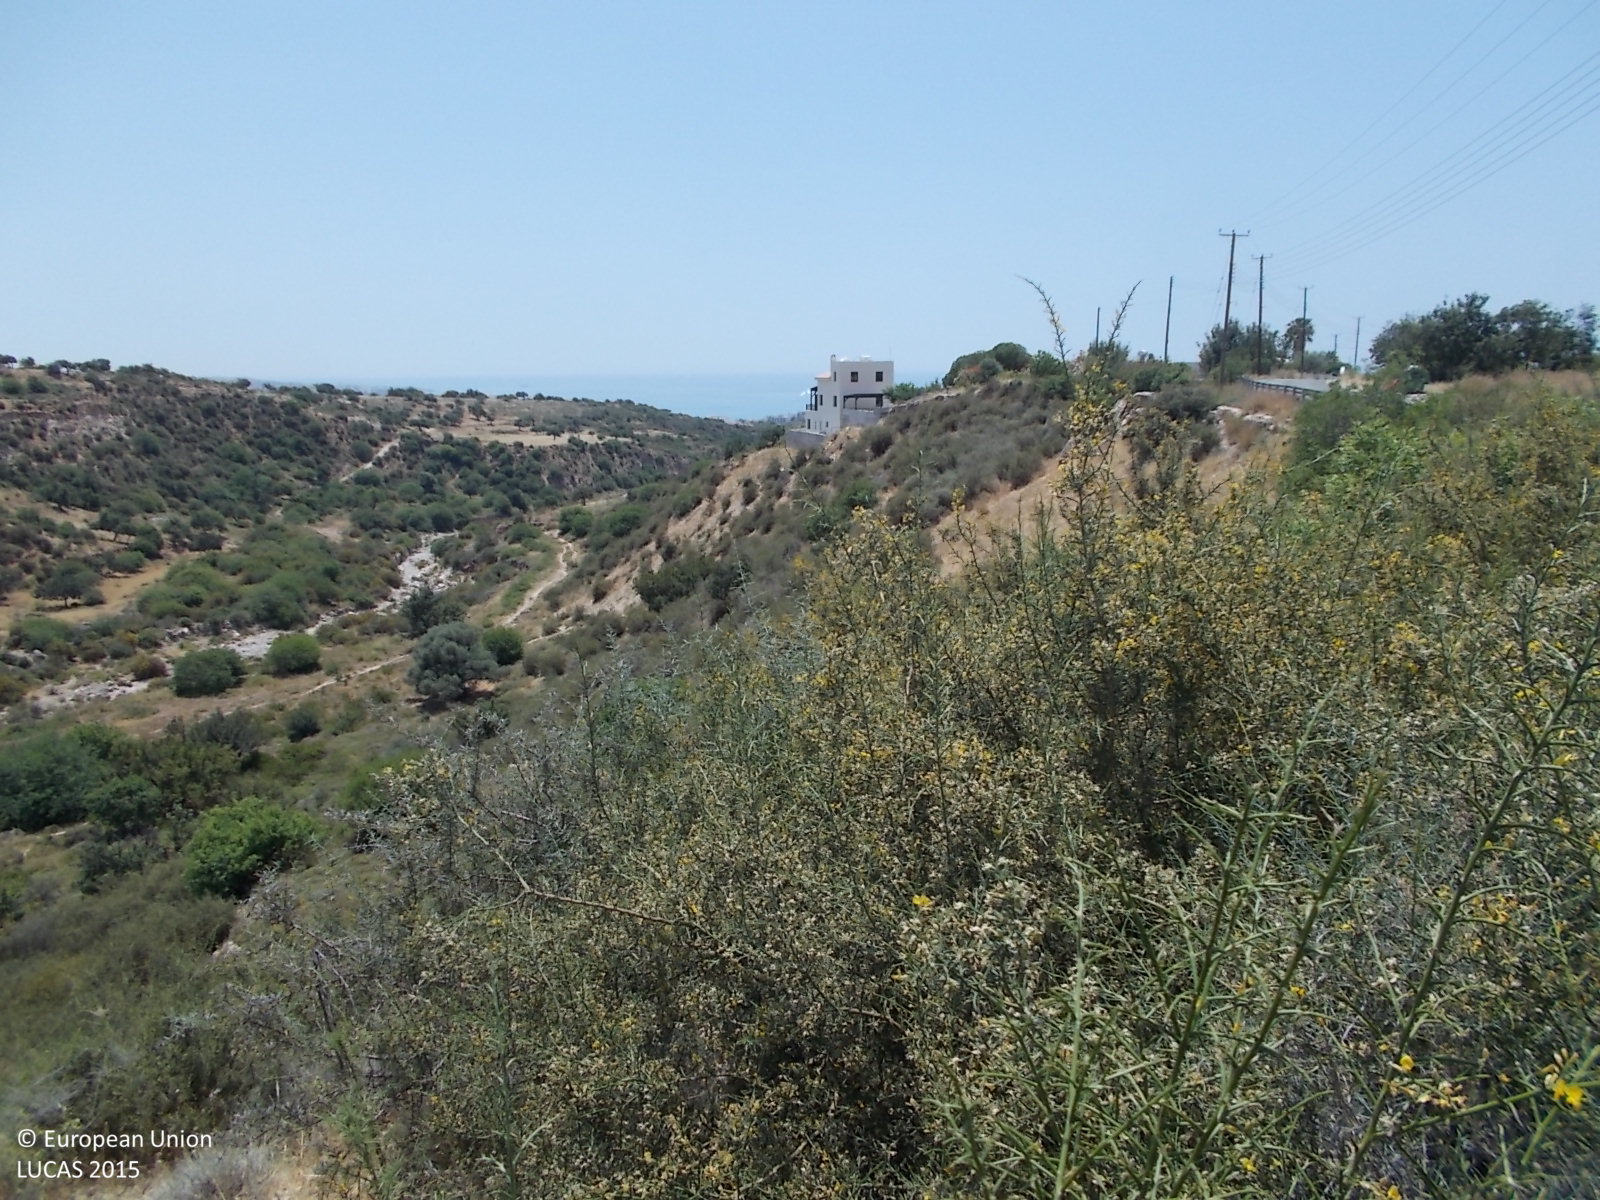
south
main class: Shrubland
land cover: Shrubland without tree cover
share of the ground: > 75 %
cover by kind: shrubs 75 %, herbaceous plants 15 %, unconsolidated bare surface 10 %
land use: Semi-natural and natural areas not in use
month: May
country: CY
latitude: 34.8734
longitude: 32.3875
